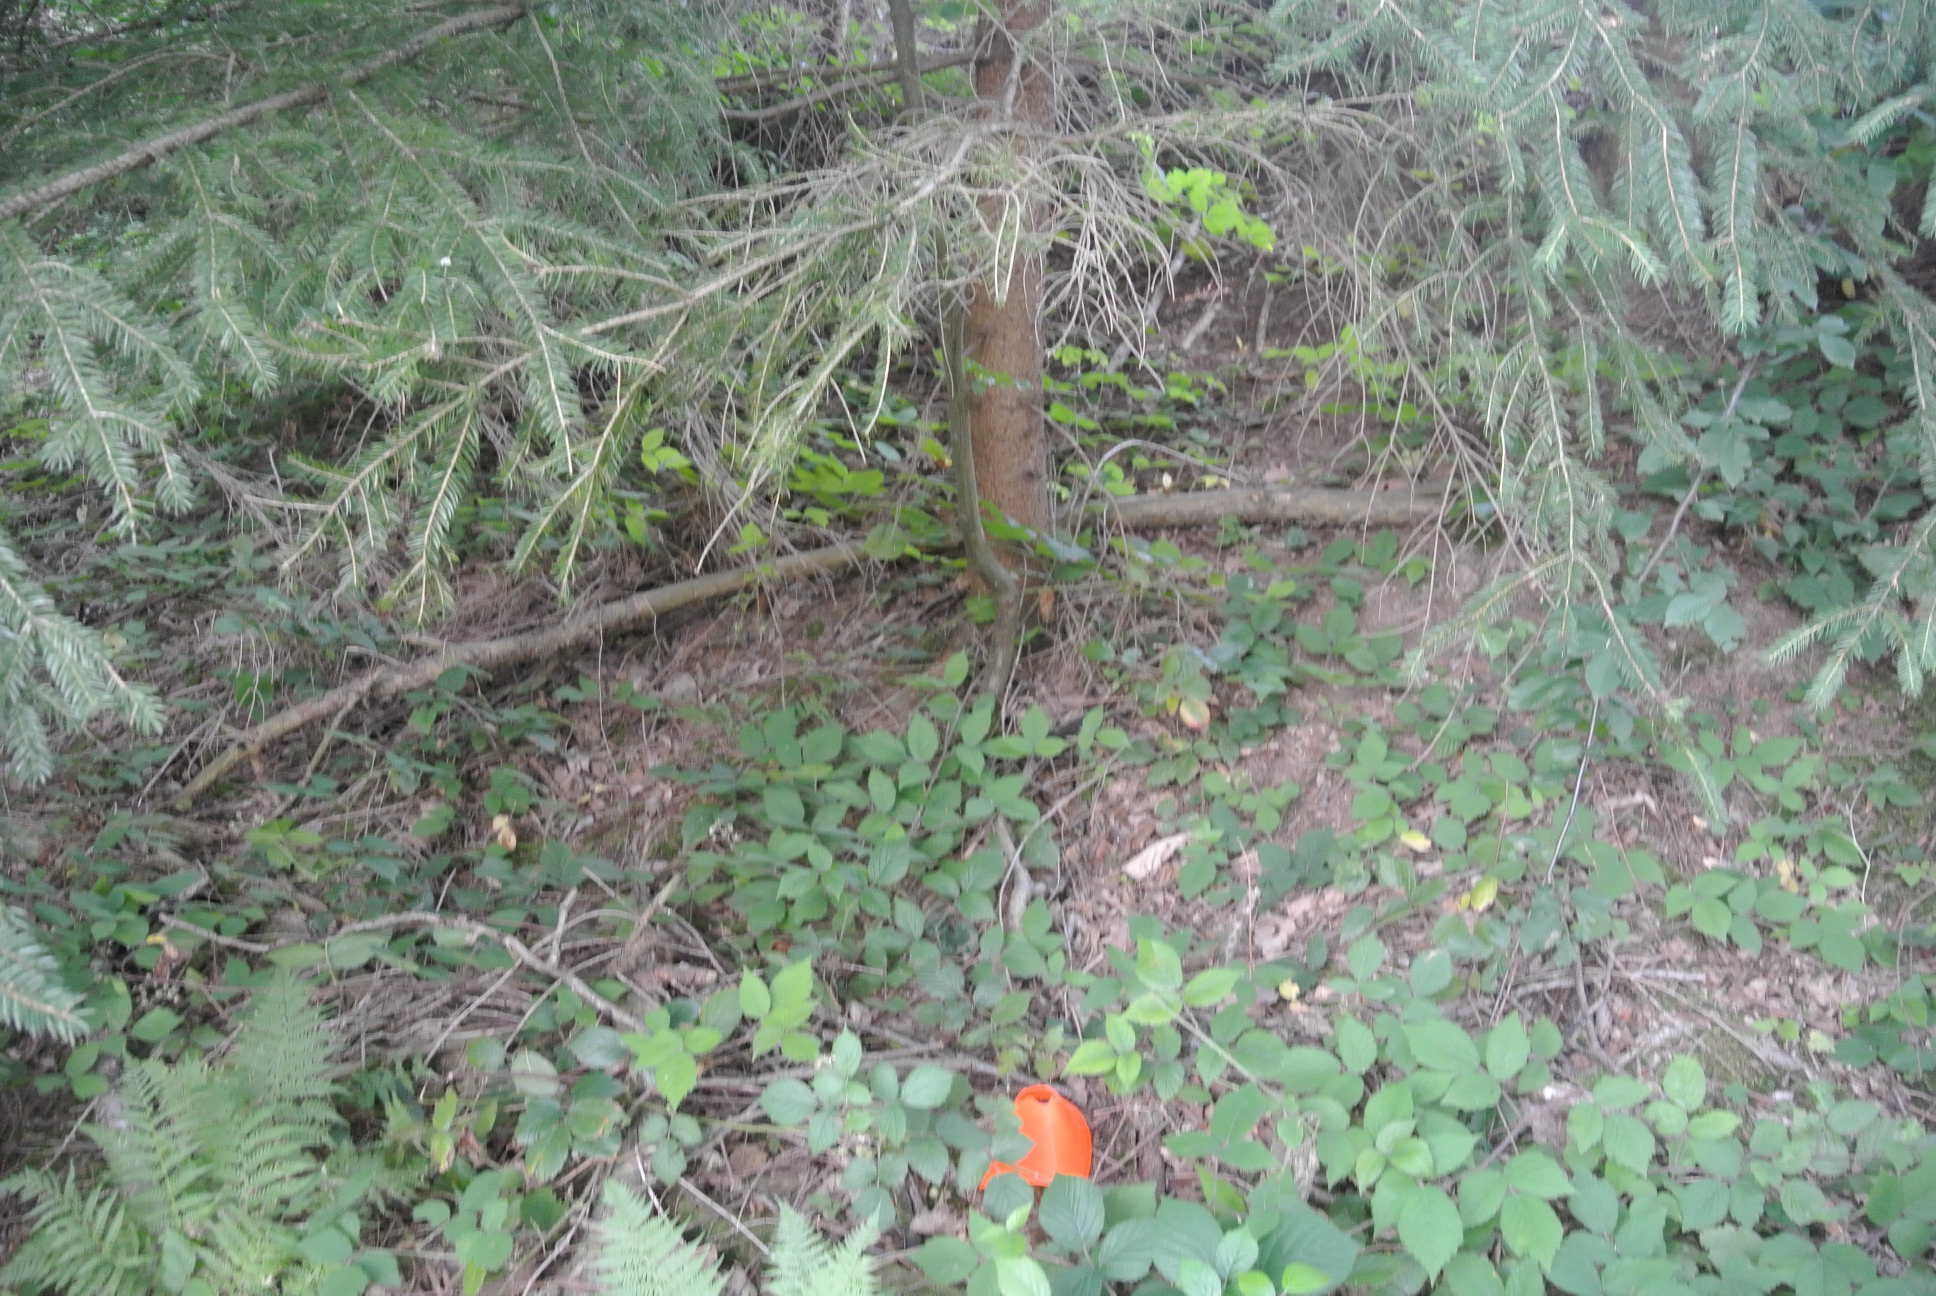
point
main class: Woodland
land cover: Spruce dominated mixed woodland
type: alpine coniferous forest
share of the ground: > 75 %
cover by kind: coniferous forest trees 70 %, broadleaved forest trees 30 %
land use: Forestry
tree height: > 5 m
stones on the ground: < 10 %
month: July
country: AT
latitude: 47.6568
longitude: 16.1144
